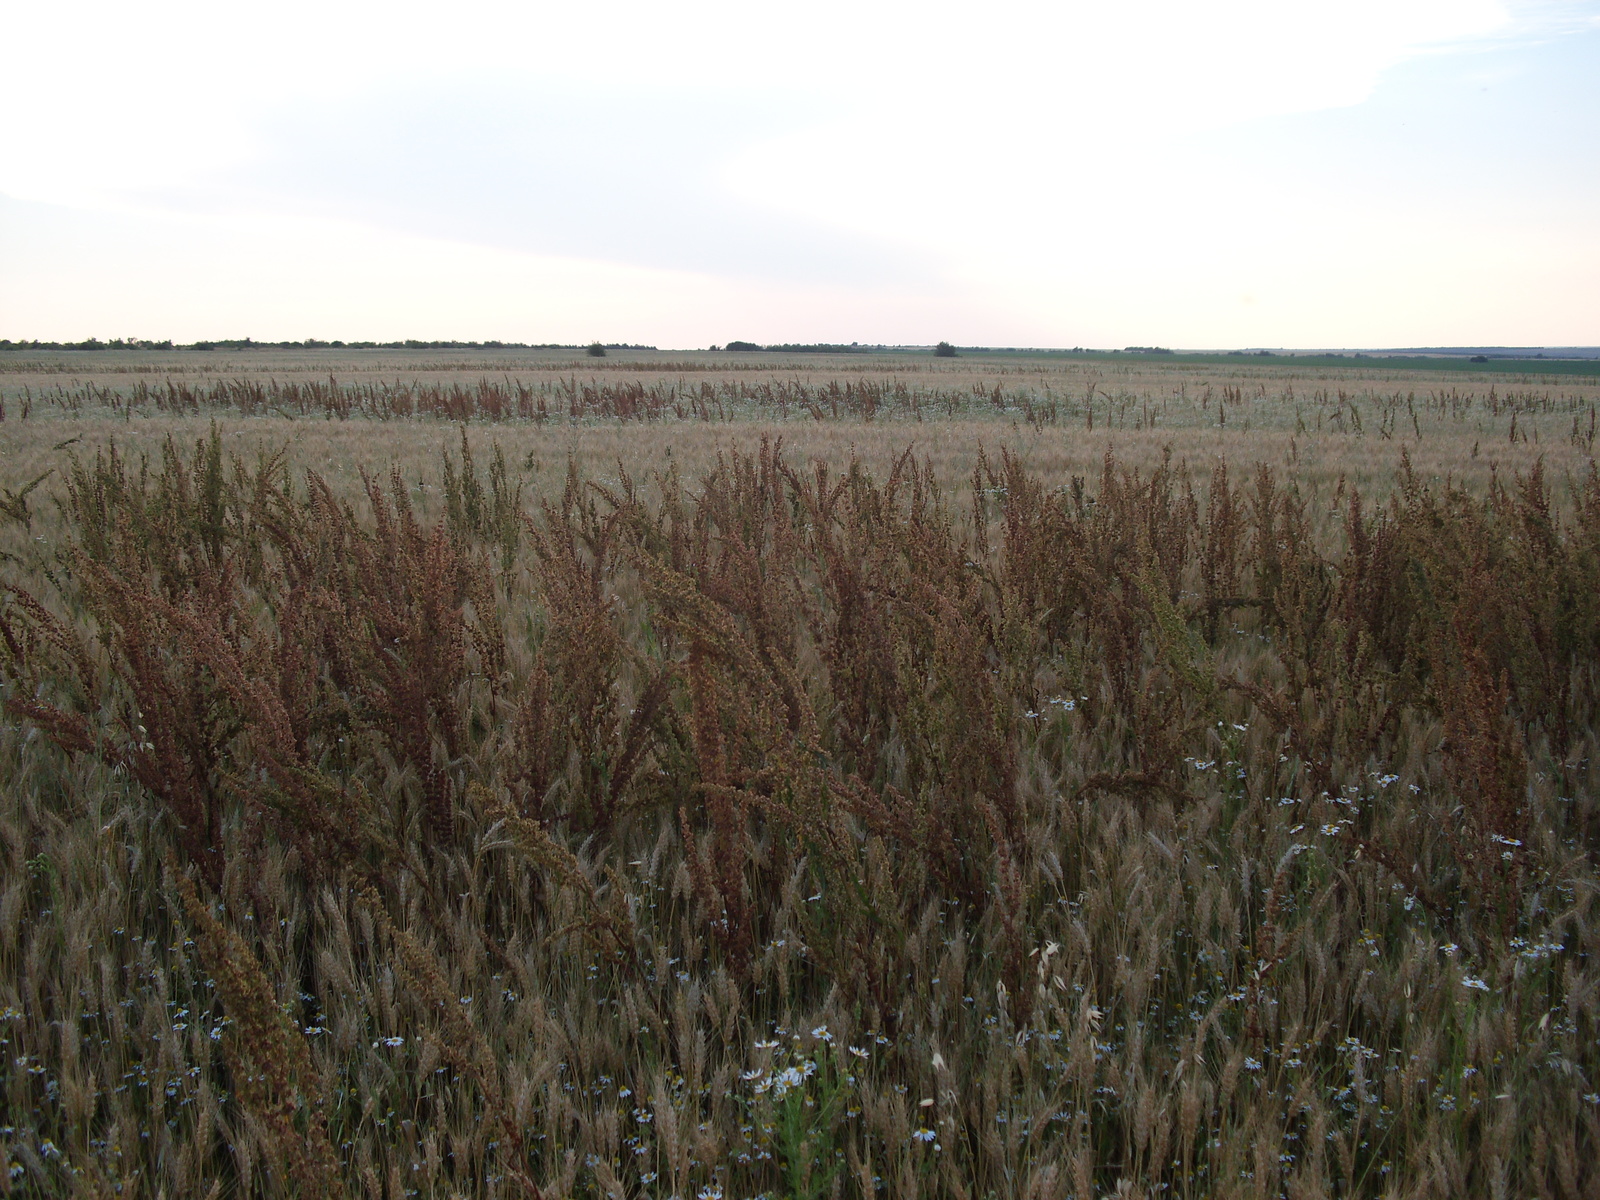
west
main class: Cropland
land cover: Common wheat
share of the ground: > 75 %
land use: Agriculture (excluding fallow land and kitchen gardens)
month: June
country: BG
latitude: 43.4357
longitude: 23.5732
